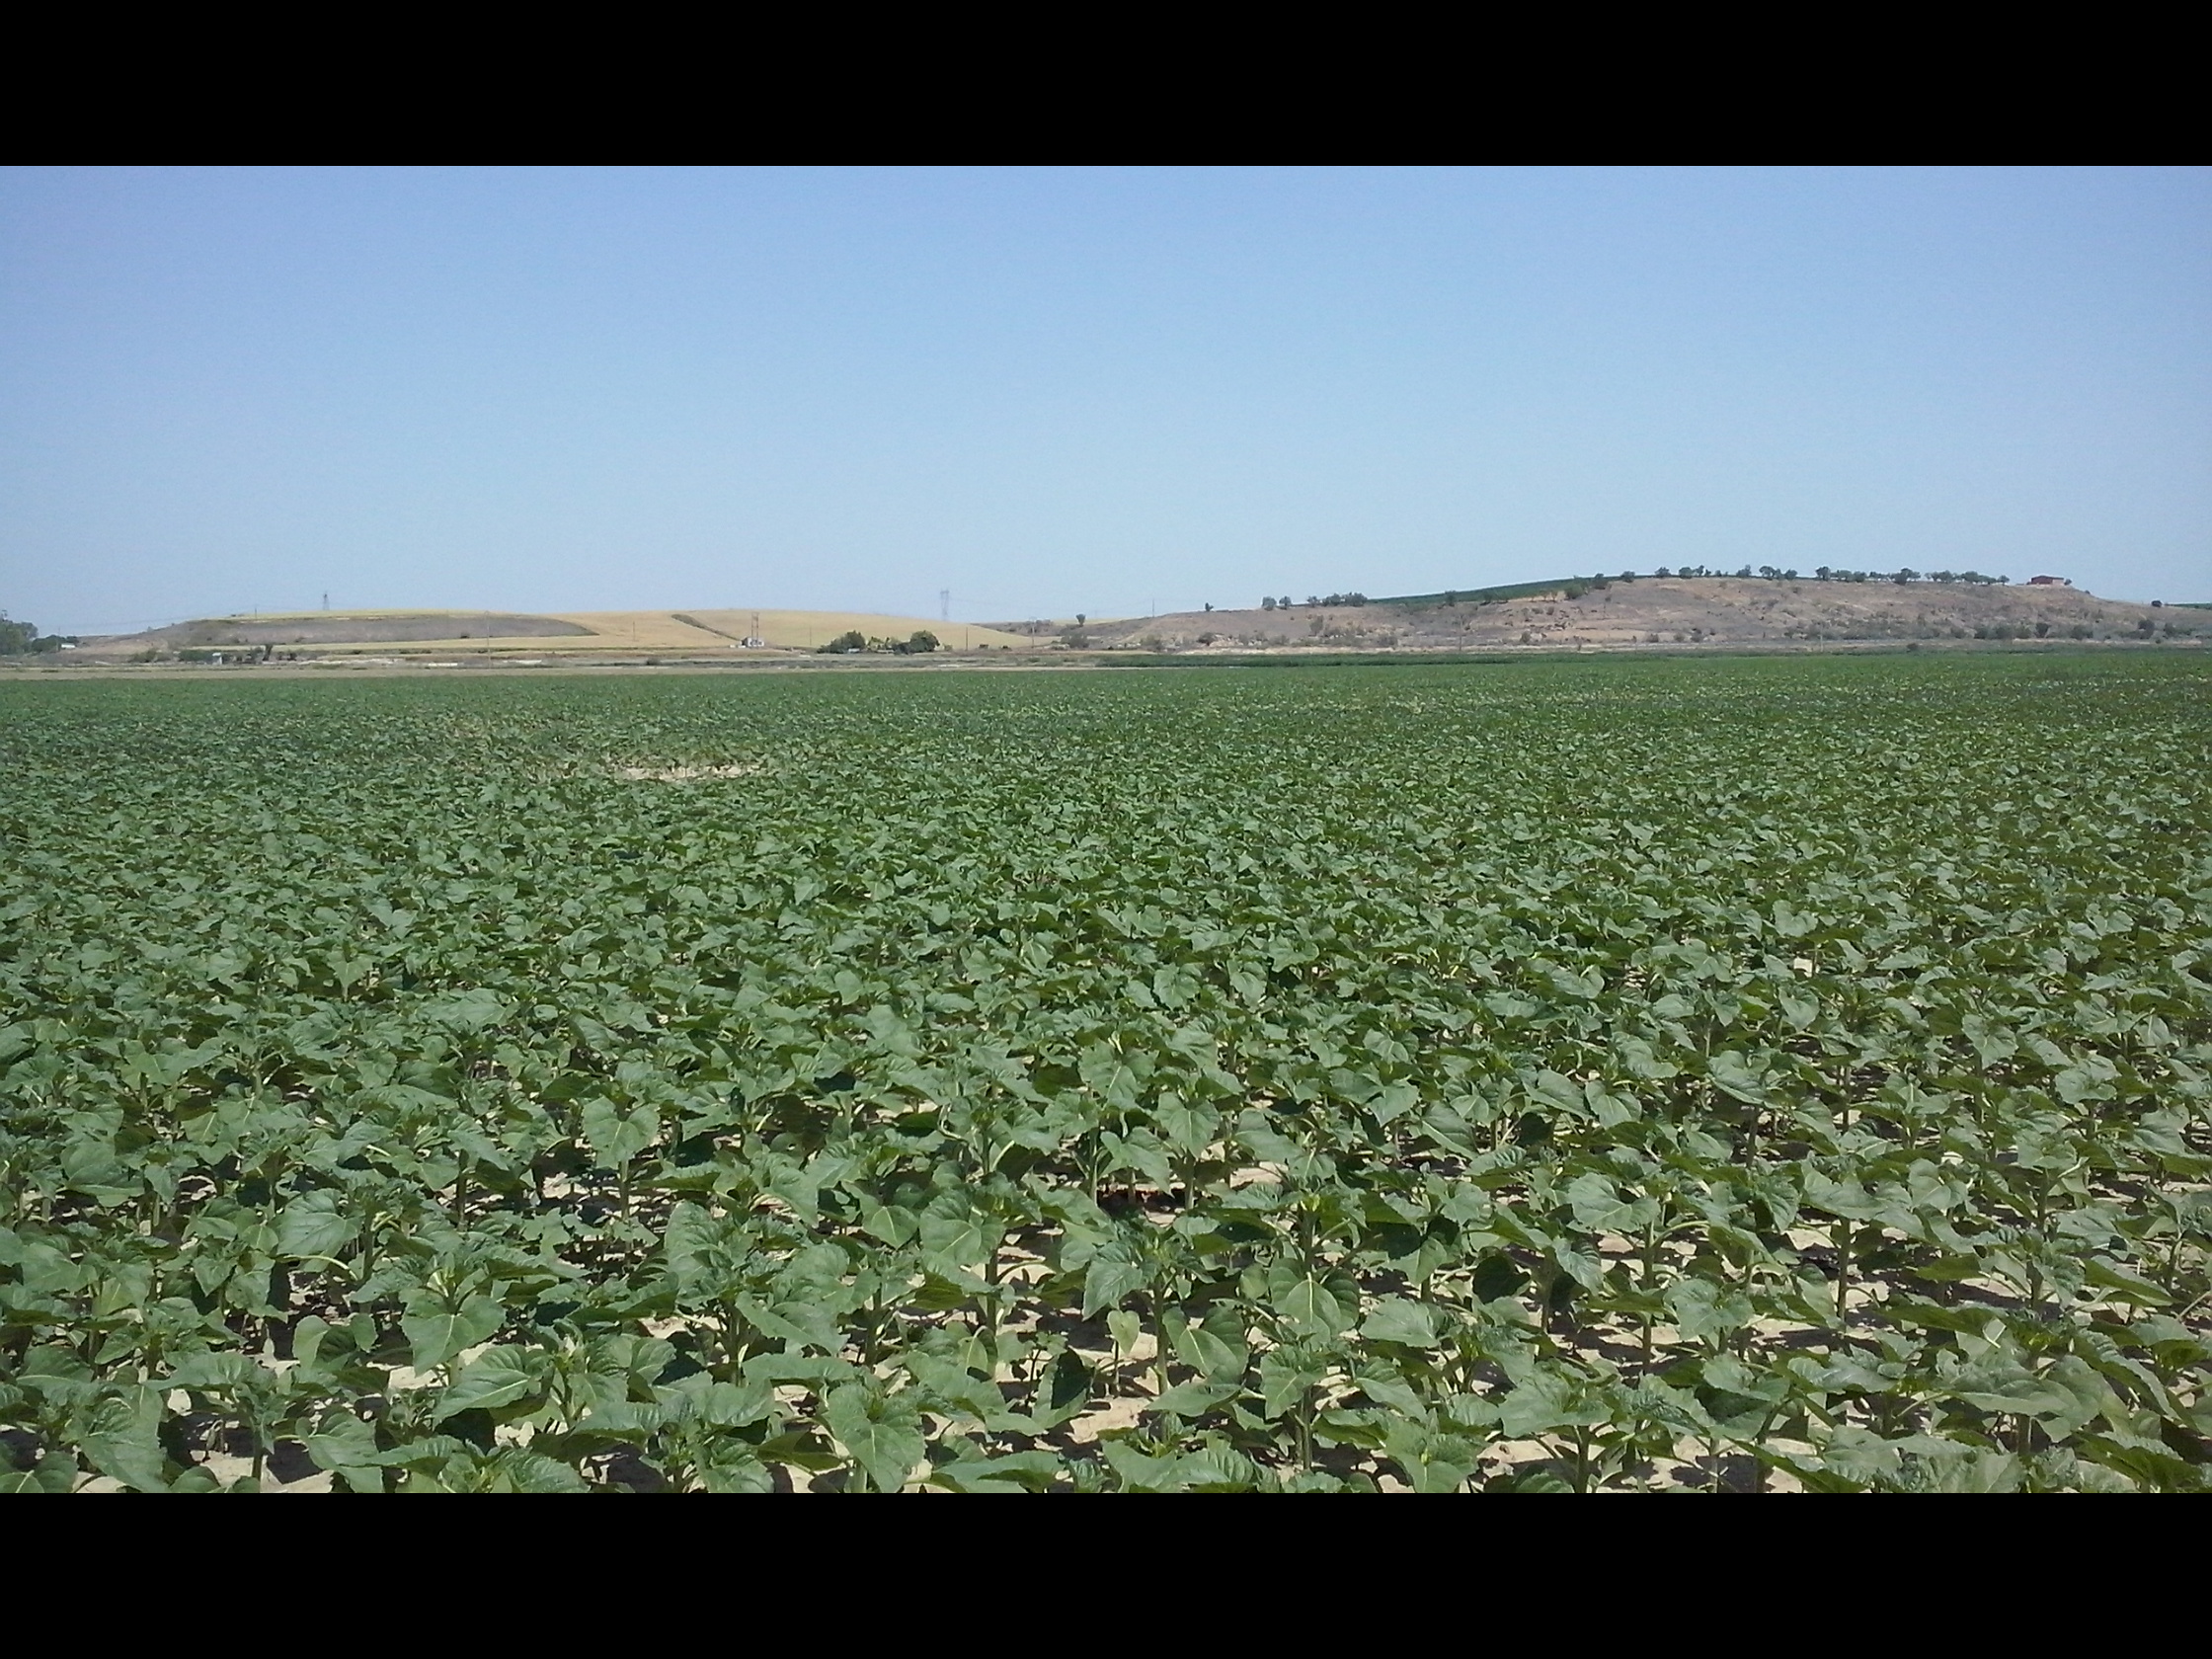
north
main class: Cropland
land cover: Sunflower
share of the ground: > 75 %
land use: Agriculture (excluding fallow land and kitchen gardens)
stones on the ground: < 10 %
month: June
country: ES
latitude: 41.4809
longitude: -5.0791
